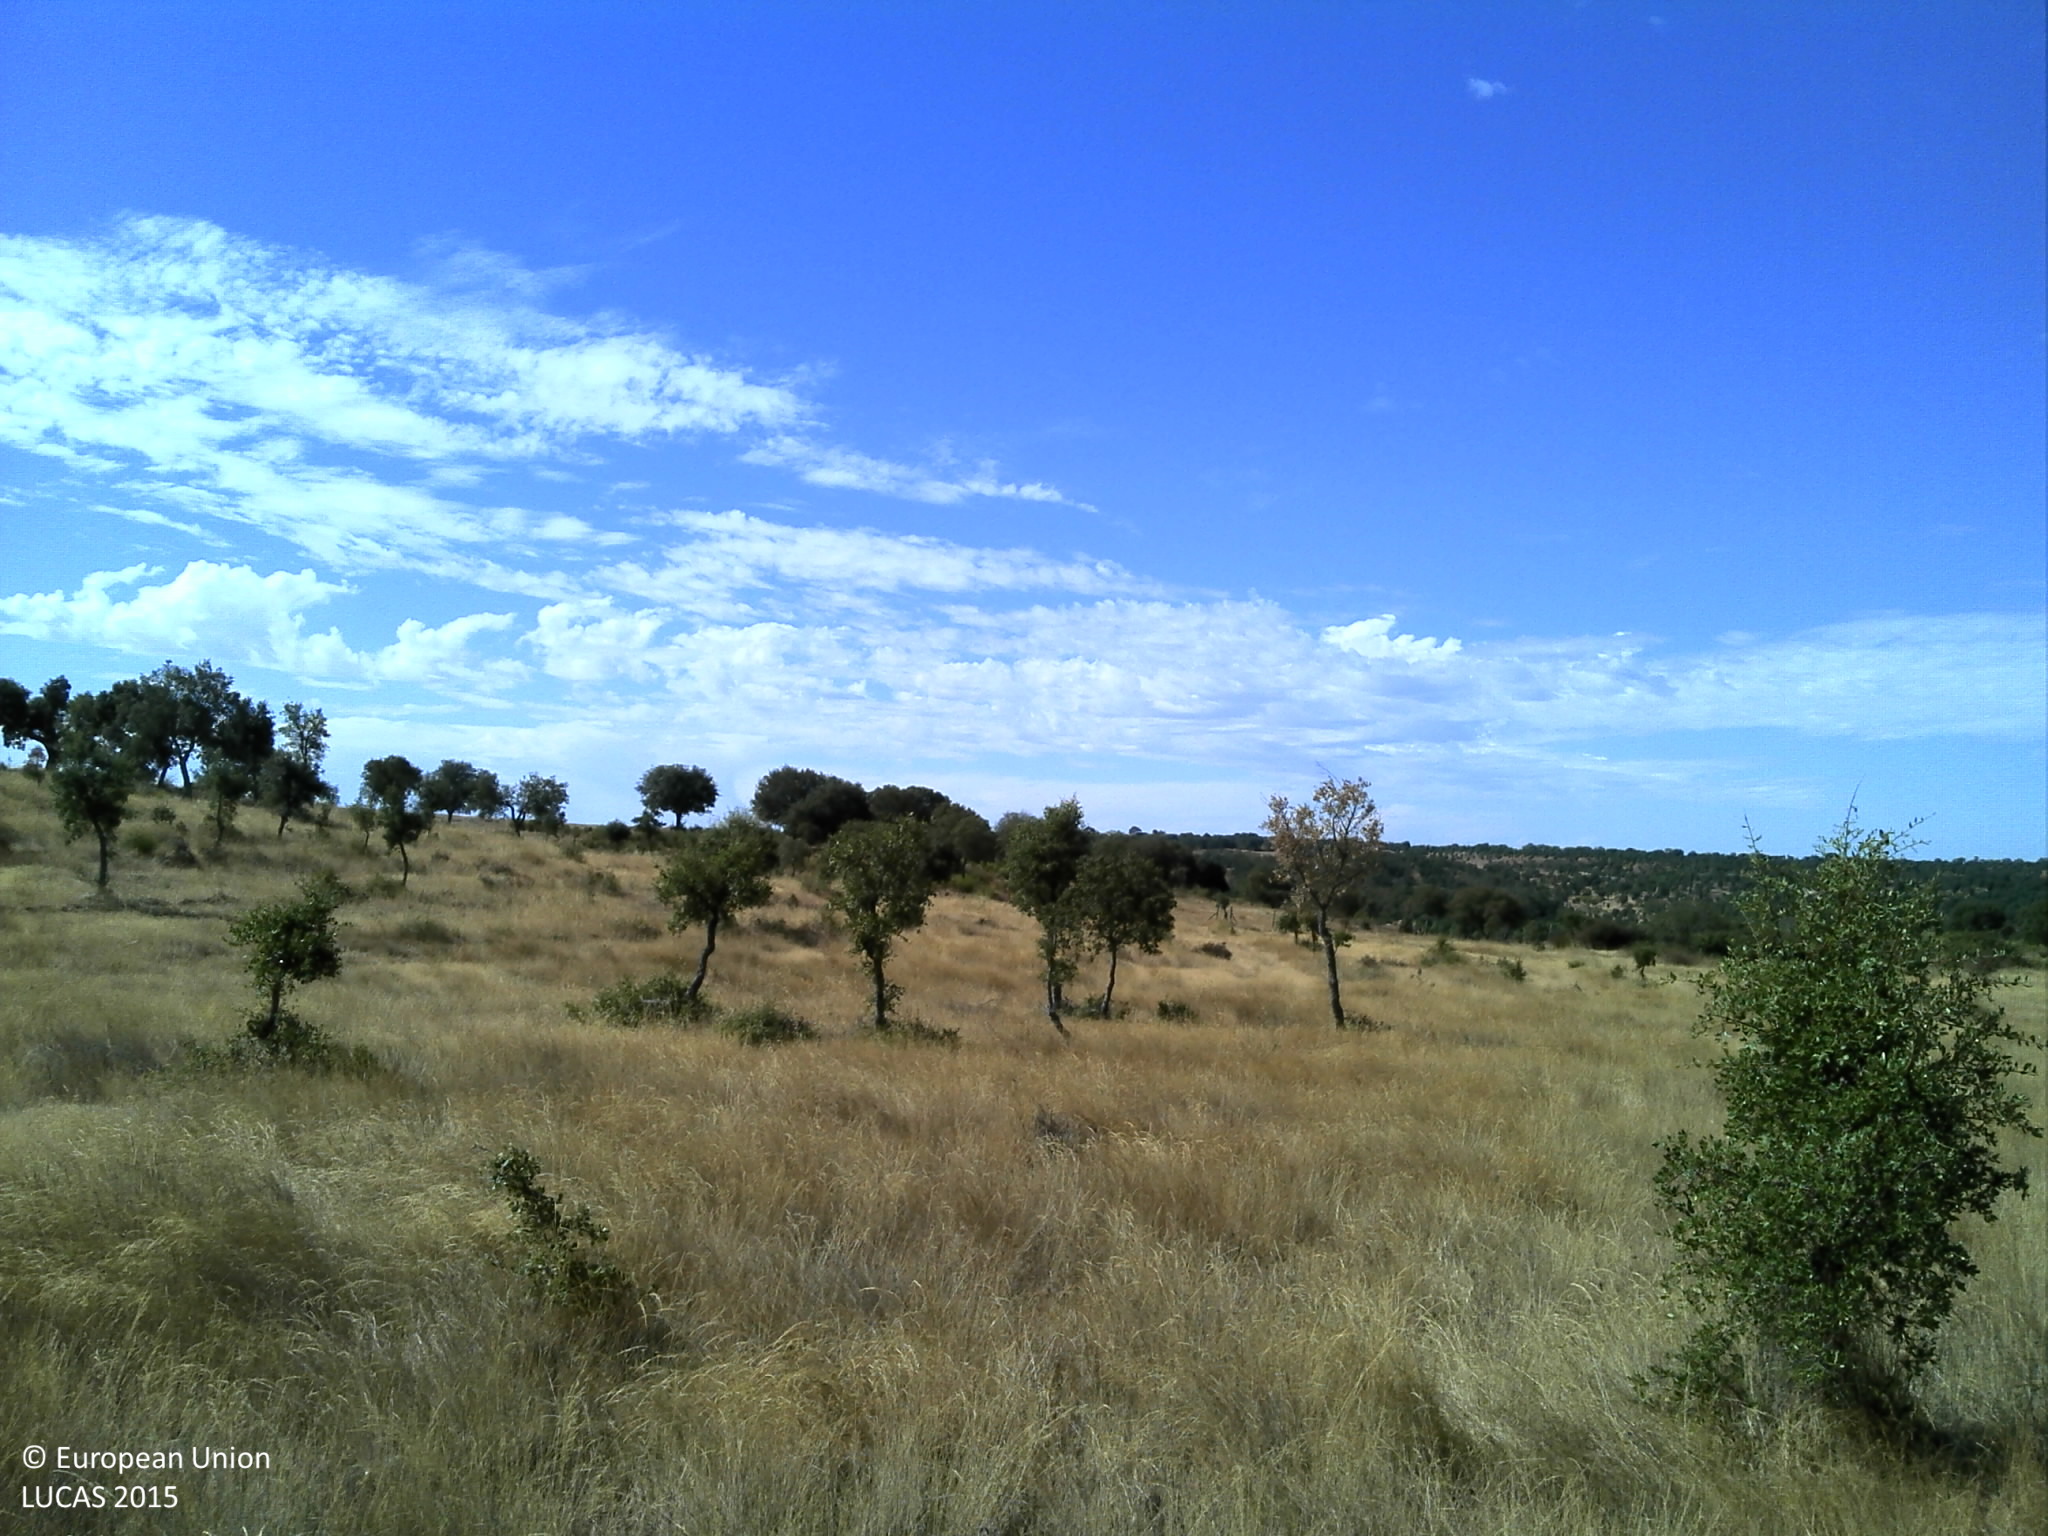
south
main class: Woodland
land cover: Broadleaved woodland
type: broadleaved evergreen forest
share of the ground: 10 - 25 %
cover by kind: unconsolidated bare surface 65 %, herbaceous plants 25 %, broadleaved forest trees 10 %
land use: Forestry
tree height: < 5 m
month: August
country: PT
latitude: 39.5165
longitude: -7.6733
